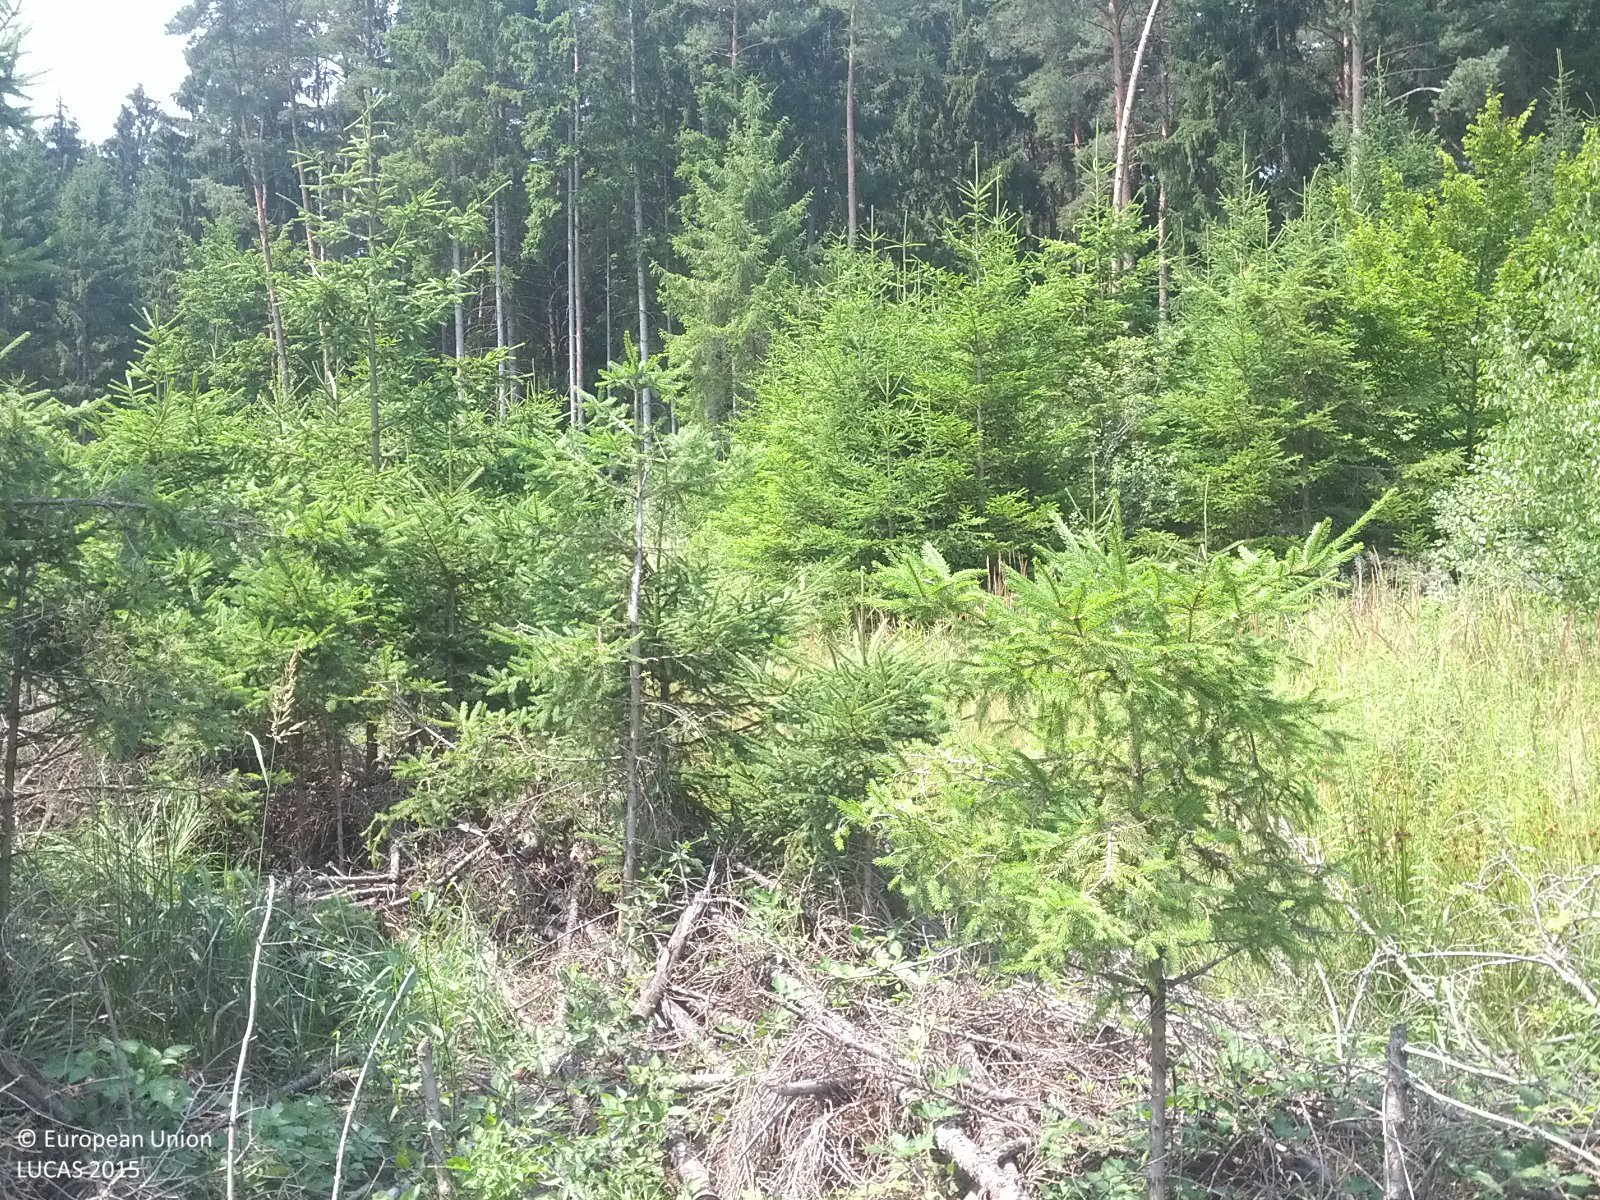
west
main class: Woodland
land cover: Spruce dominated coniferous woodland
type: alpine coniferous forest
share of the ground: > 75 %
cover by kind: coniferous forest trees 80 %, herbaceous plants 10 %, unconsolidated bare surface 10 %
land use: Forestry
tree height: > 5 m
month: July
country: AT
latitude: 47.2399
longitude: 16.1448
